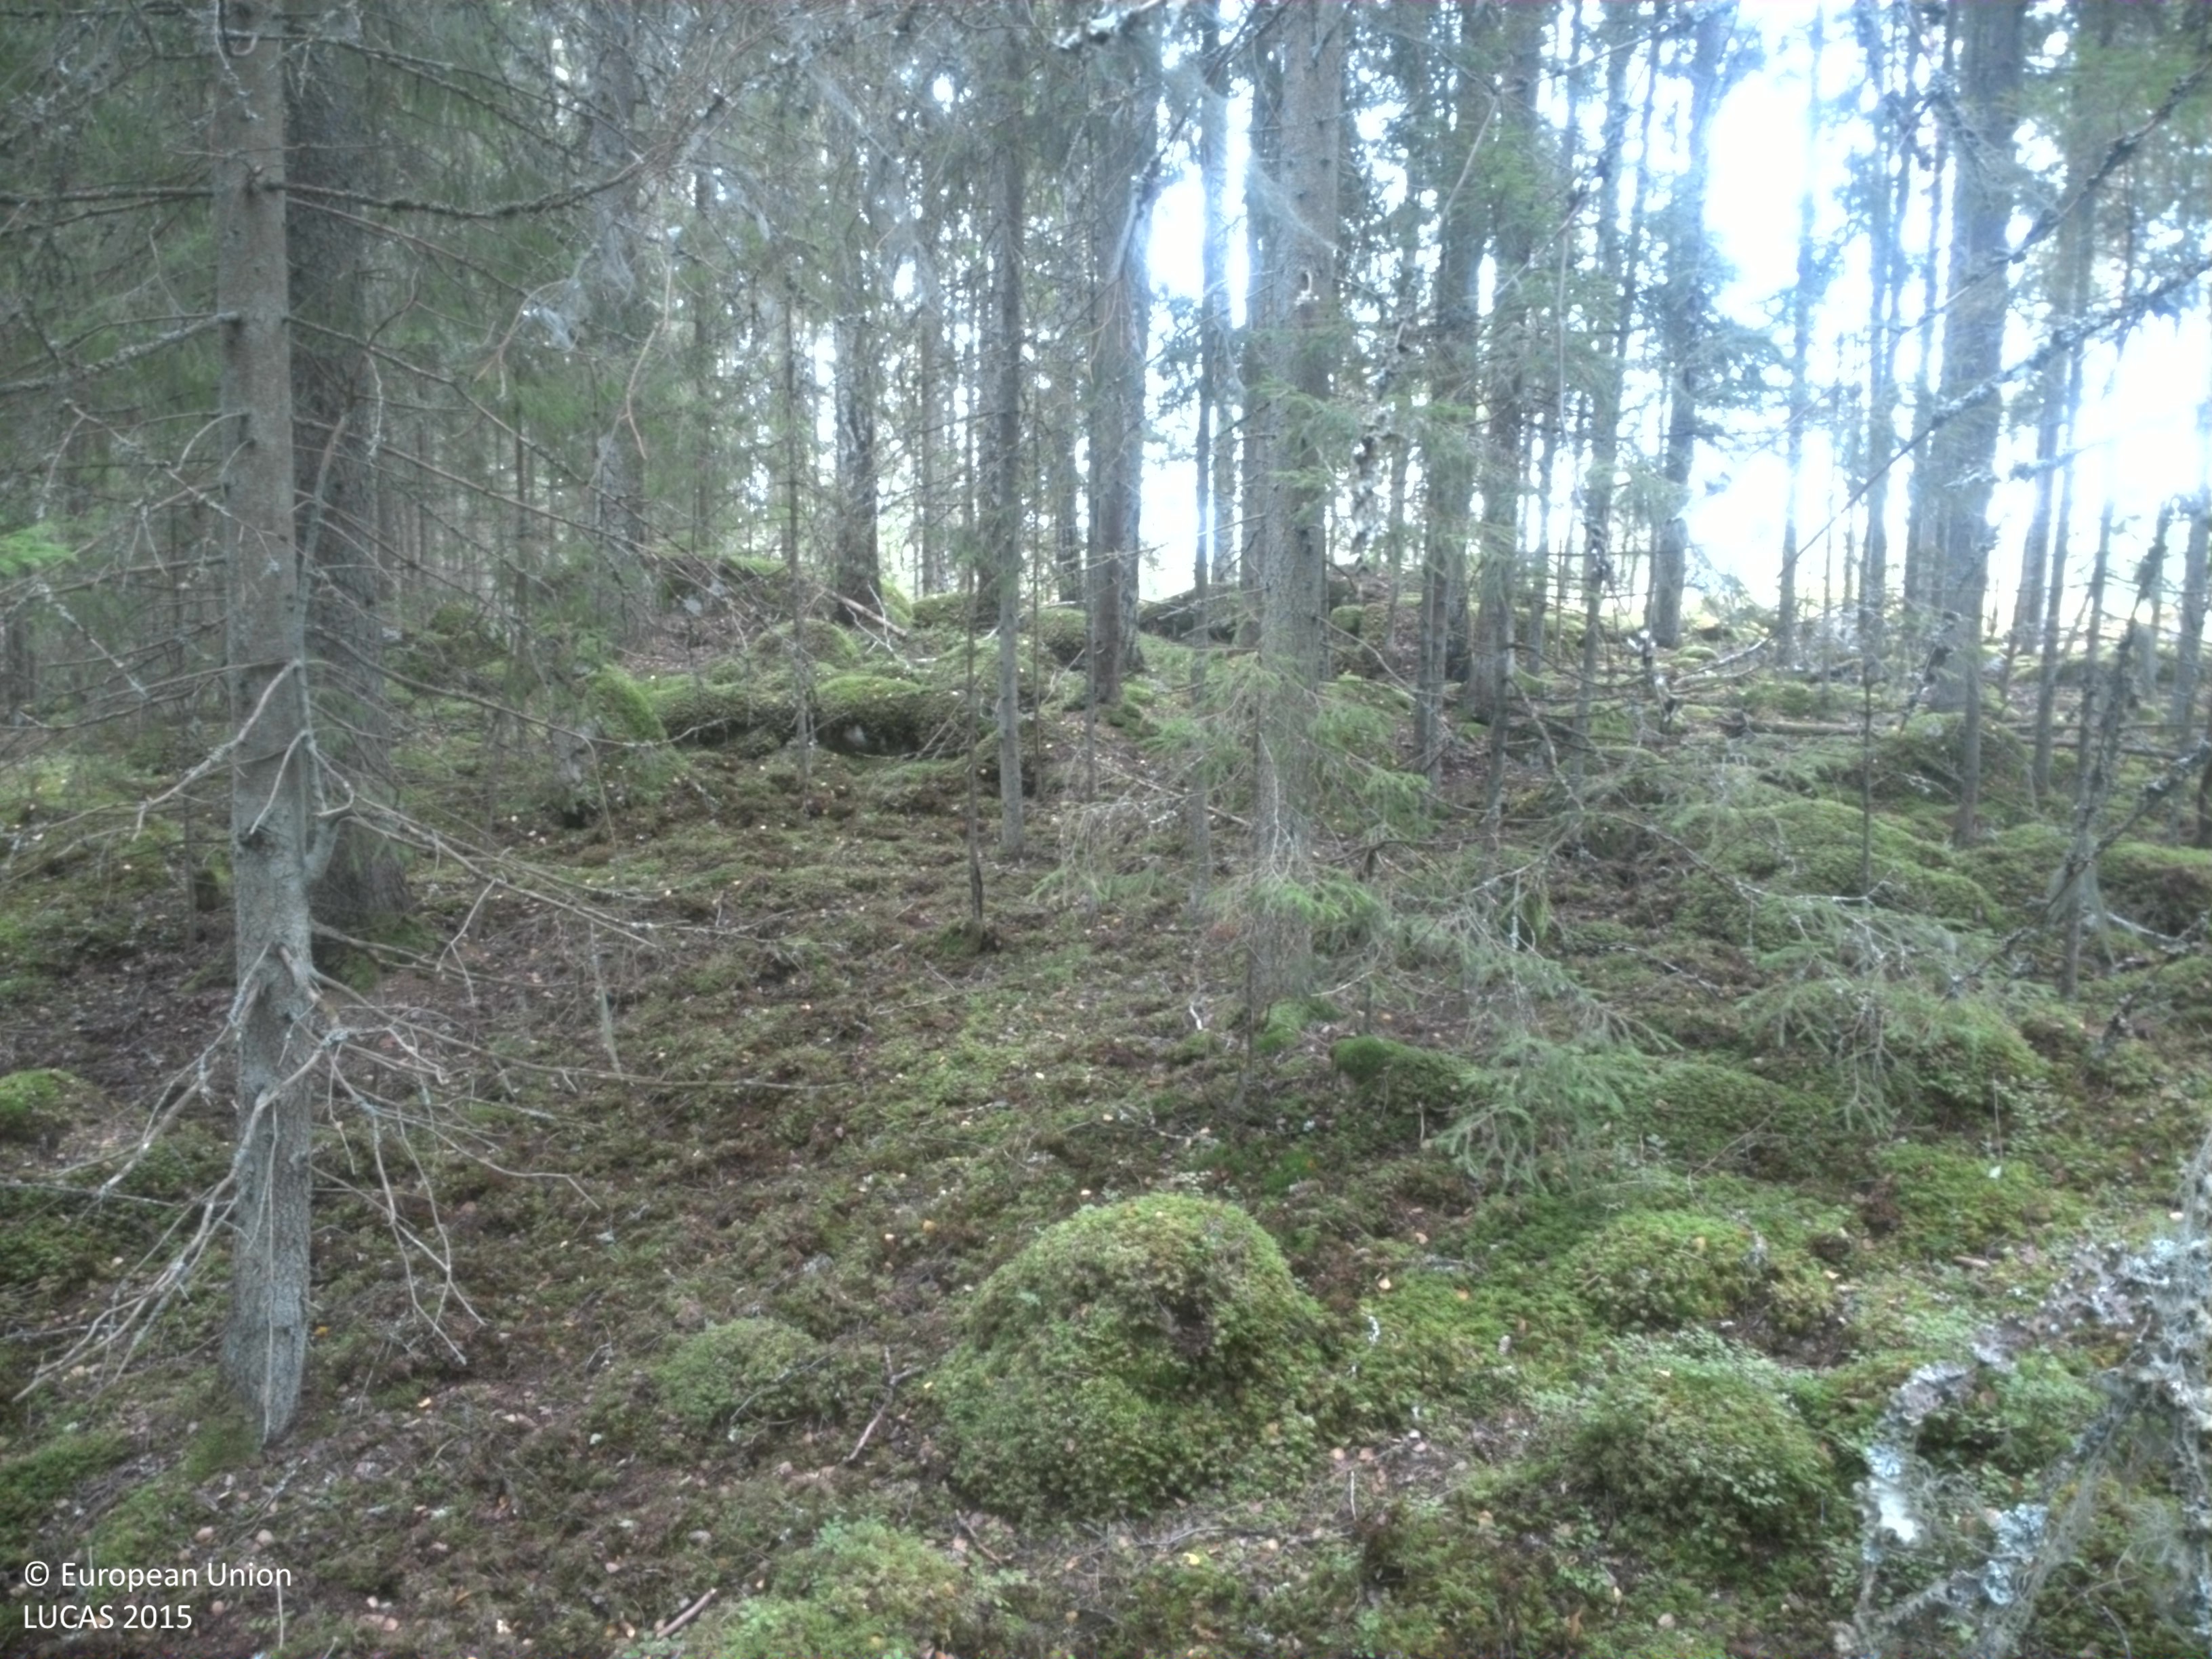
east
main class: Woodland
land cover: Spruce dominated coniferous woodland
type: boreal forest
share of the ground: > 75 %
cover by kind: coniferous forest trees 75 %, lichens and mosses 20 %, shrubs 5 %
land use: Forestry
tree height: > 5 m
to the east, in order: Spruce dominated coniferous woodland; Shrubland with sparse tree cover; Broadleaved woodland; Other mixed woodland; Shrubland with sparse tree cover
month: September
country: SE
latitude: 59.5211
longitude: 15.7711
